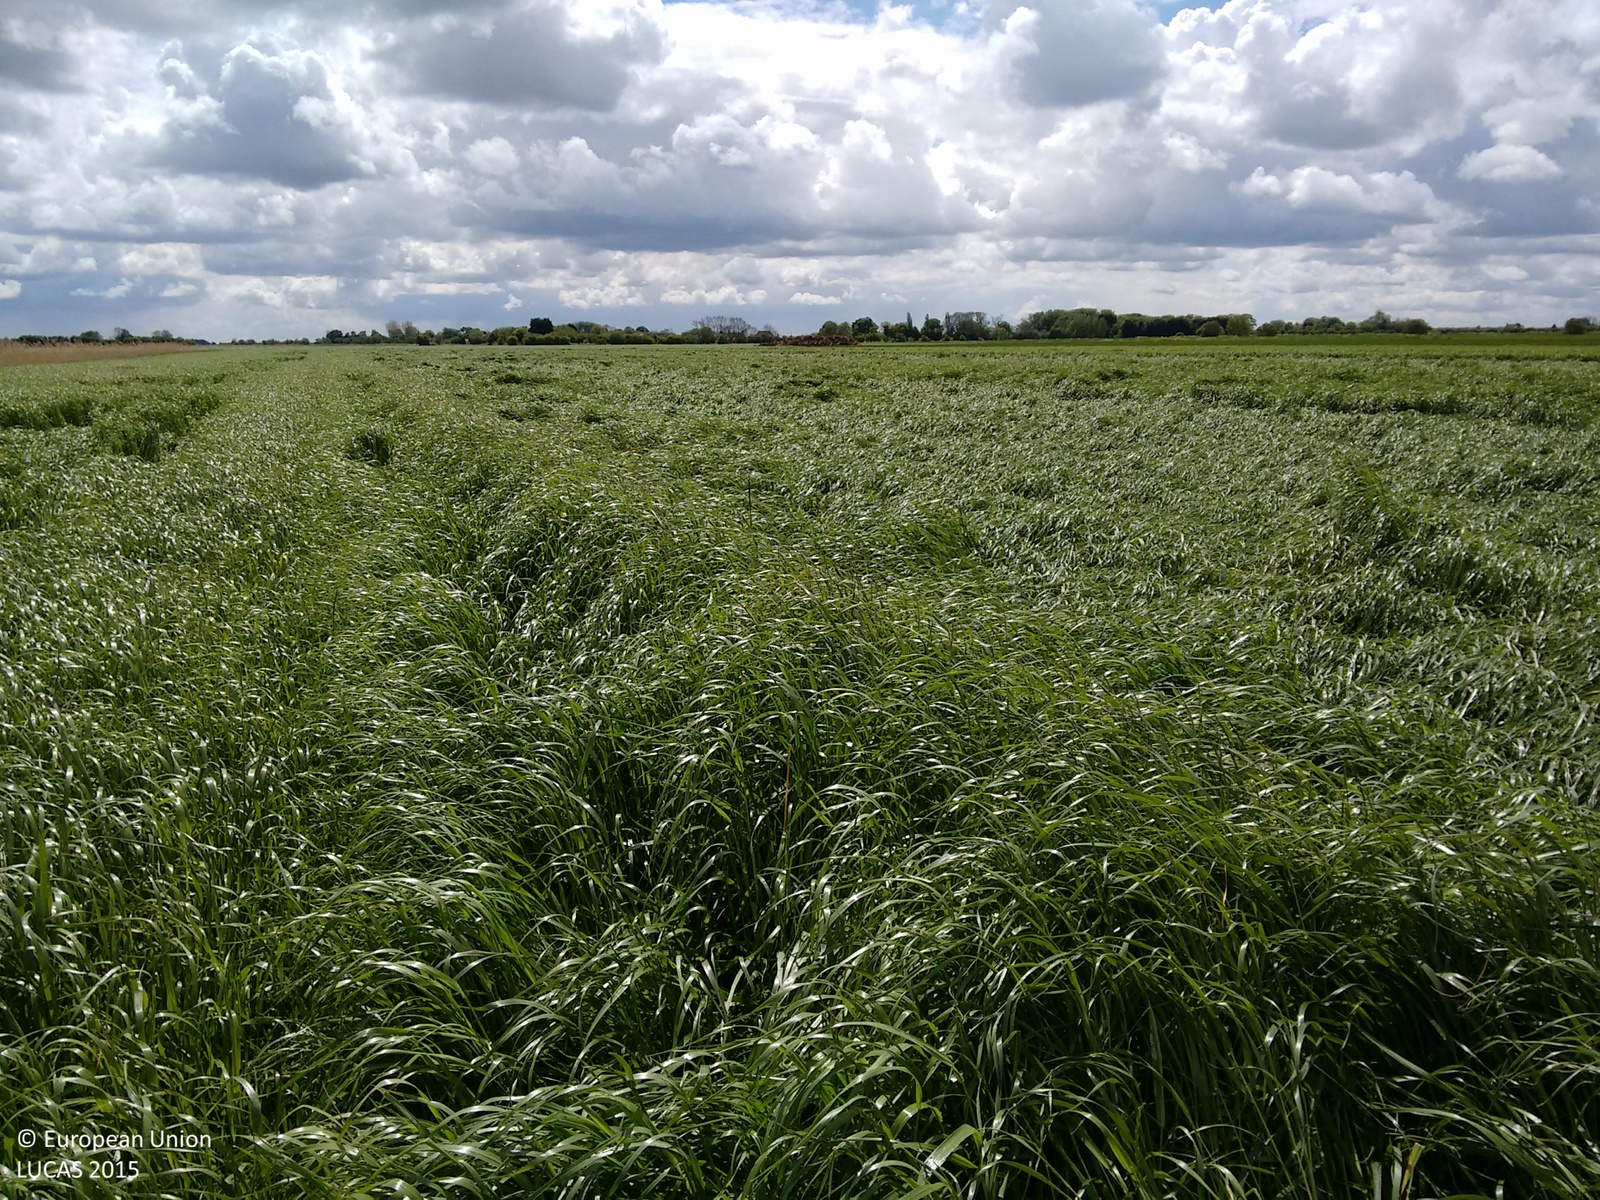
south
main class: Cropland
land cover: Common wheat
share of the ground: > 75 %
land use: Agriculture (excluding fallow land and kitchen gardens)
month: May
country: GB
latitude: 53.4004
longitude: 0.1789
